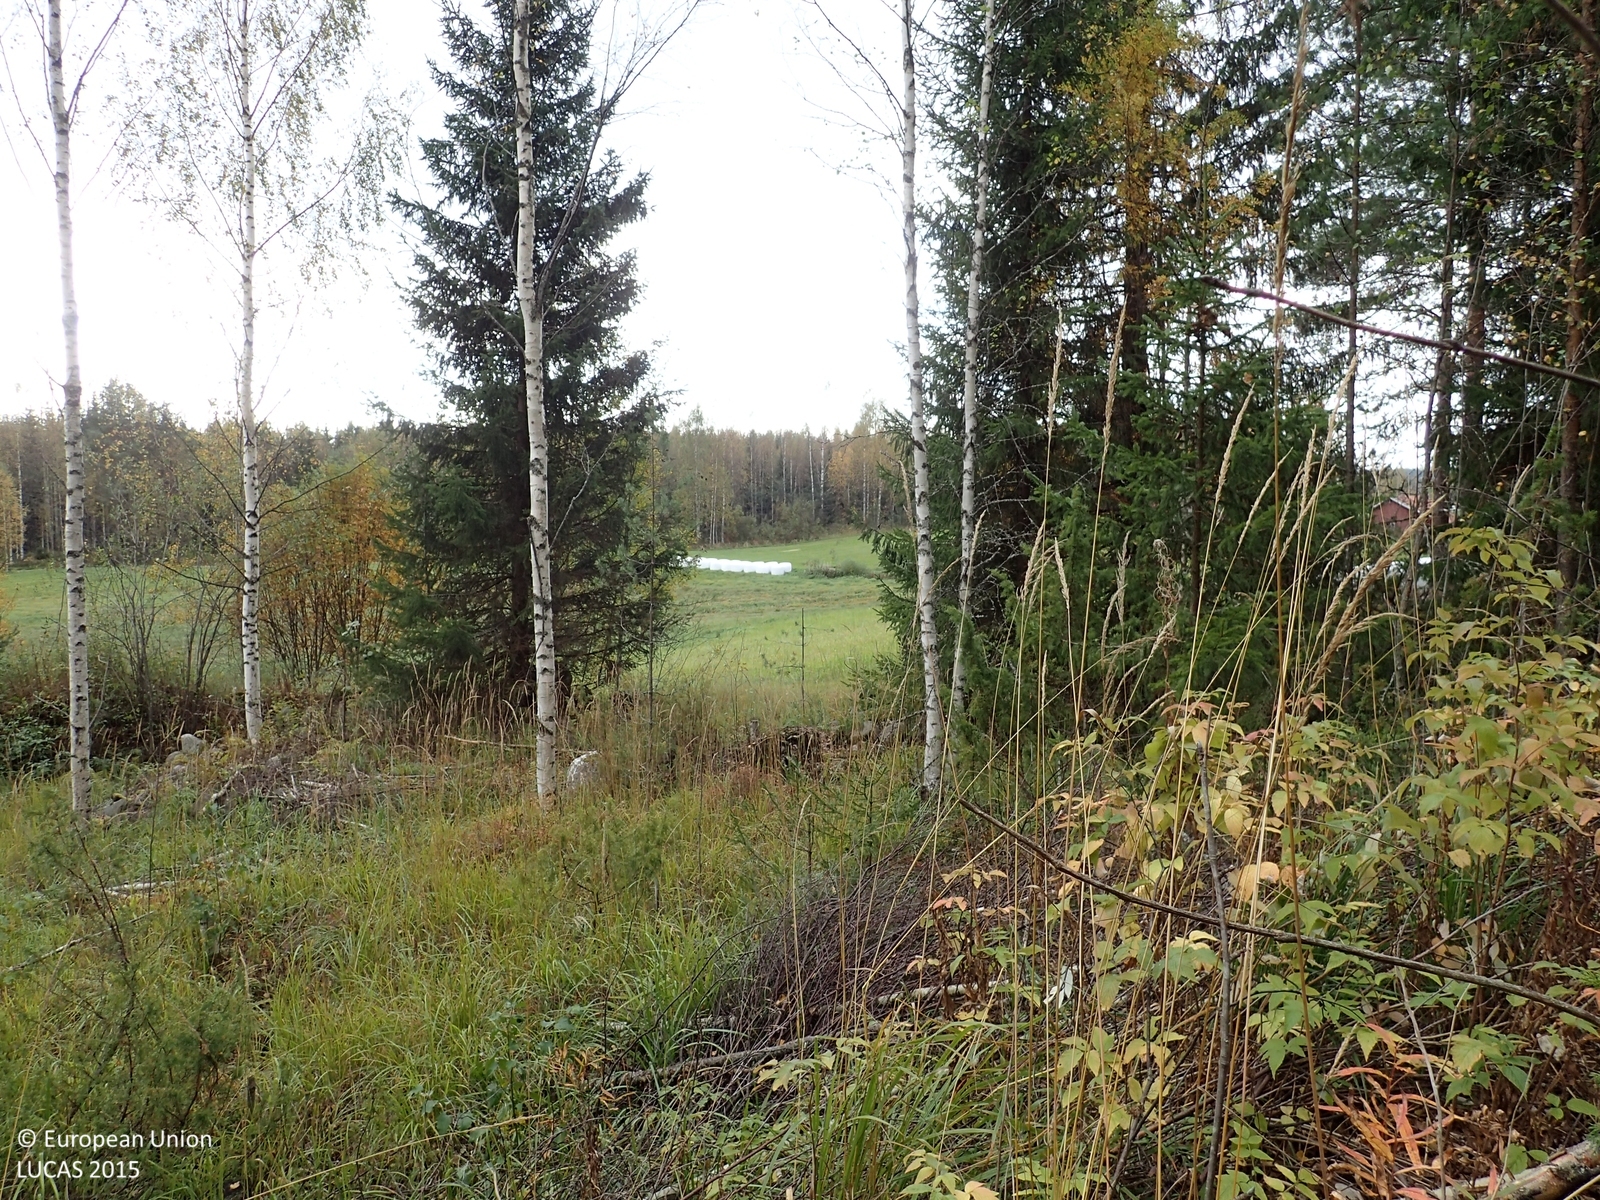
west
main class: Woodland
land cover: Pine dominated mixed woodland
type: boreal forest
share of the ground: > 75 %
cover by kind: coniferous forest trees 60 %, broadleaved forest trees 20 %, shrubs 20 %
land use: Forestry
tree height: > 5 m
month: September
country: FI
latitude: 62.9187
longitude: 26.4540
